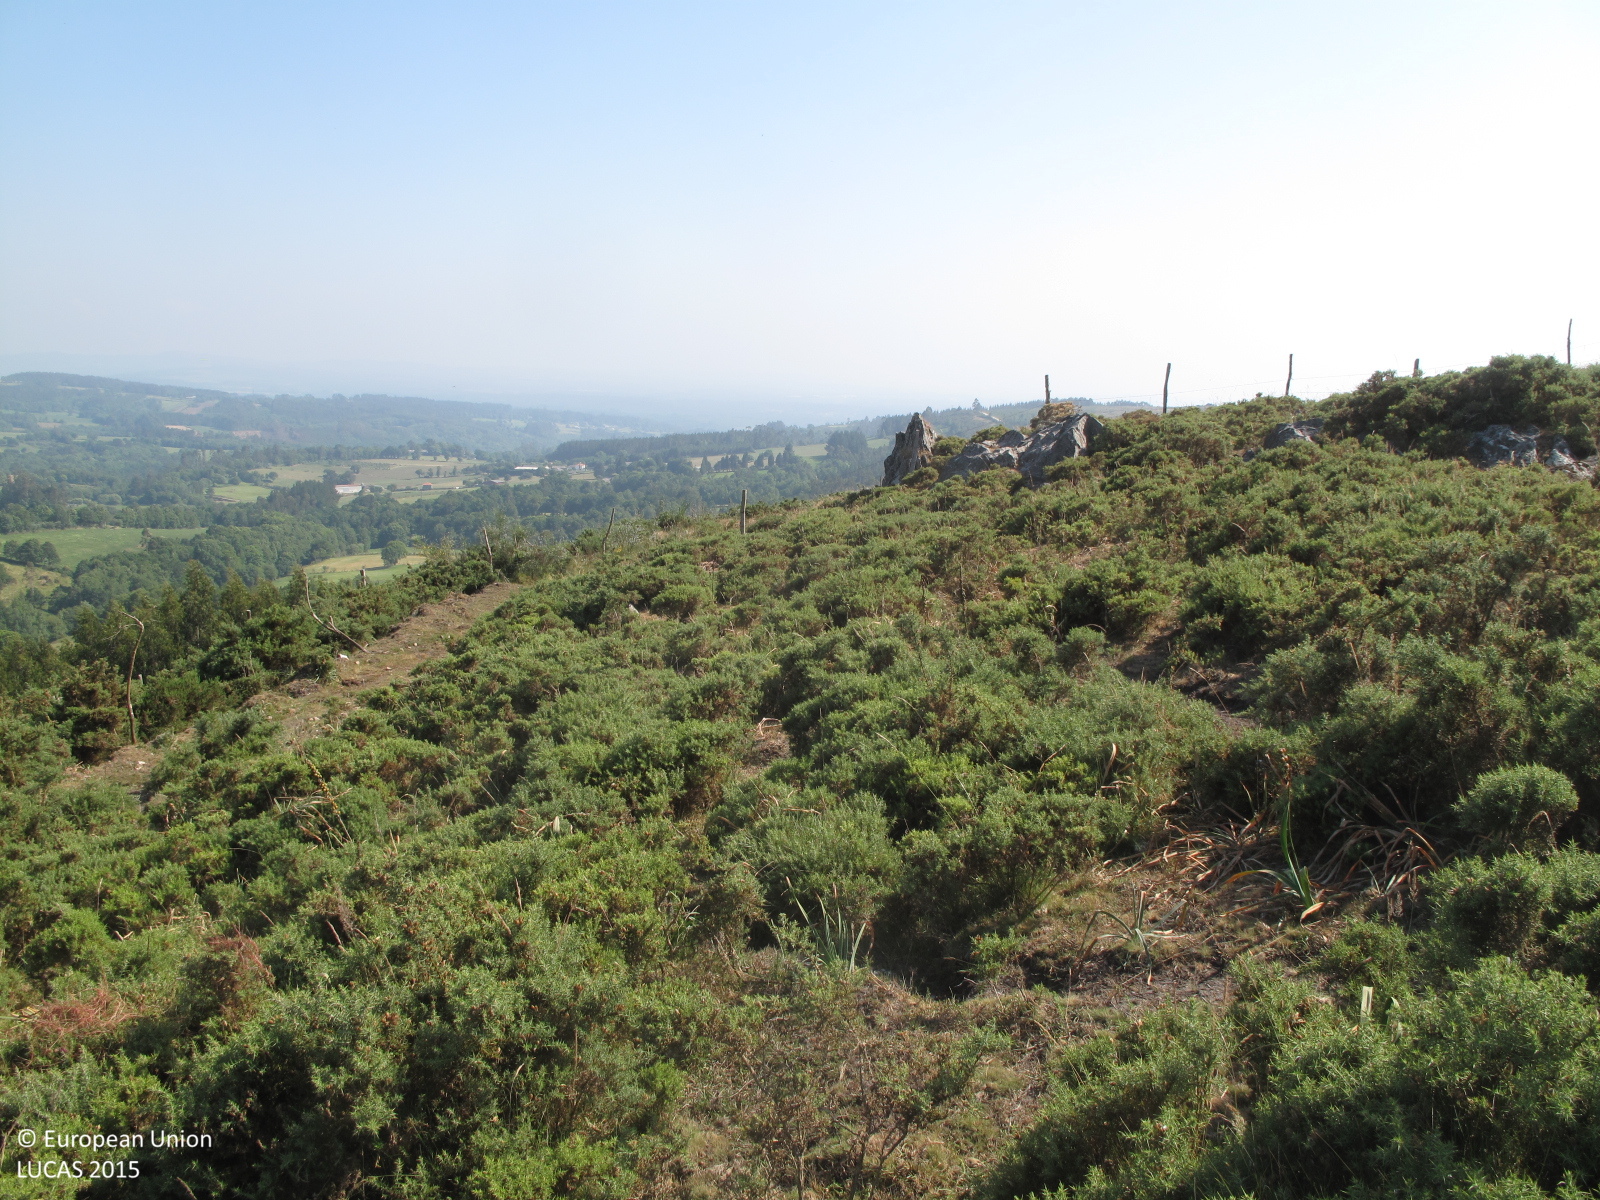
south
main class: Shrubland
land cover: Shrubland without tree cover
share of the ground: > 75 %
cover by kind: shrubs 80 %, herbaceous plants 10 %, unconsolidated bare surface 10 %
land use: Abandoned areas
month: June
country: ES
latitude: 43.2600
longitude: -7.9921
